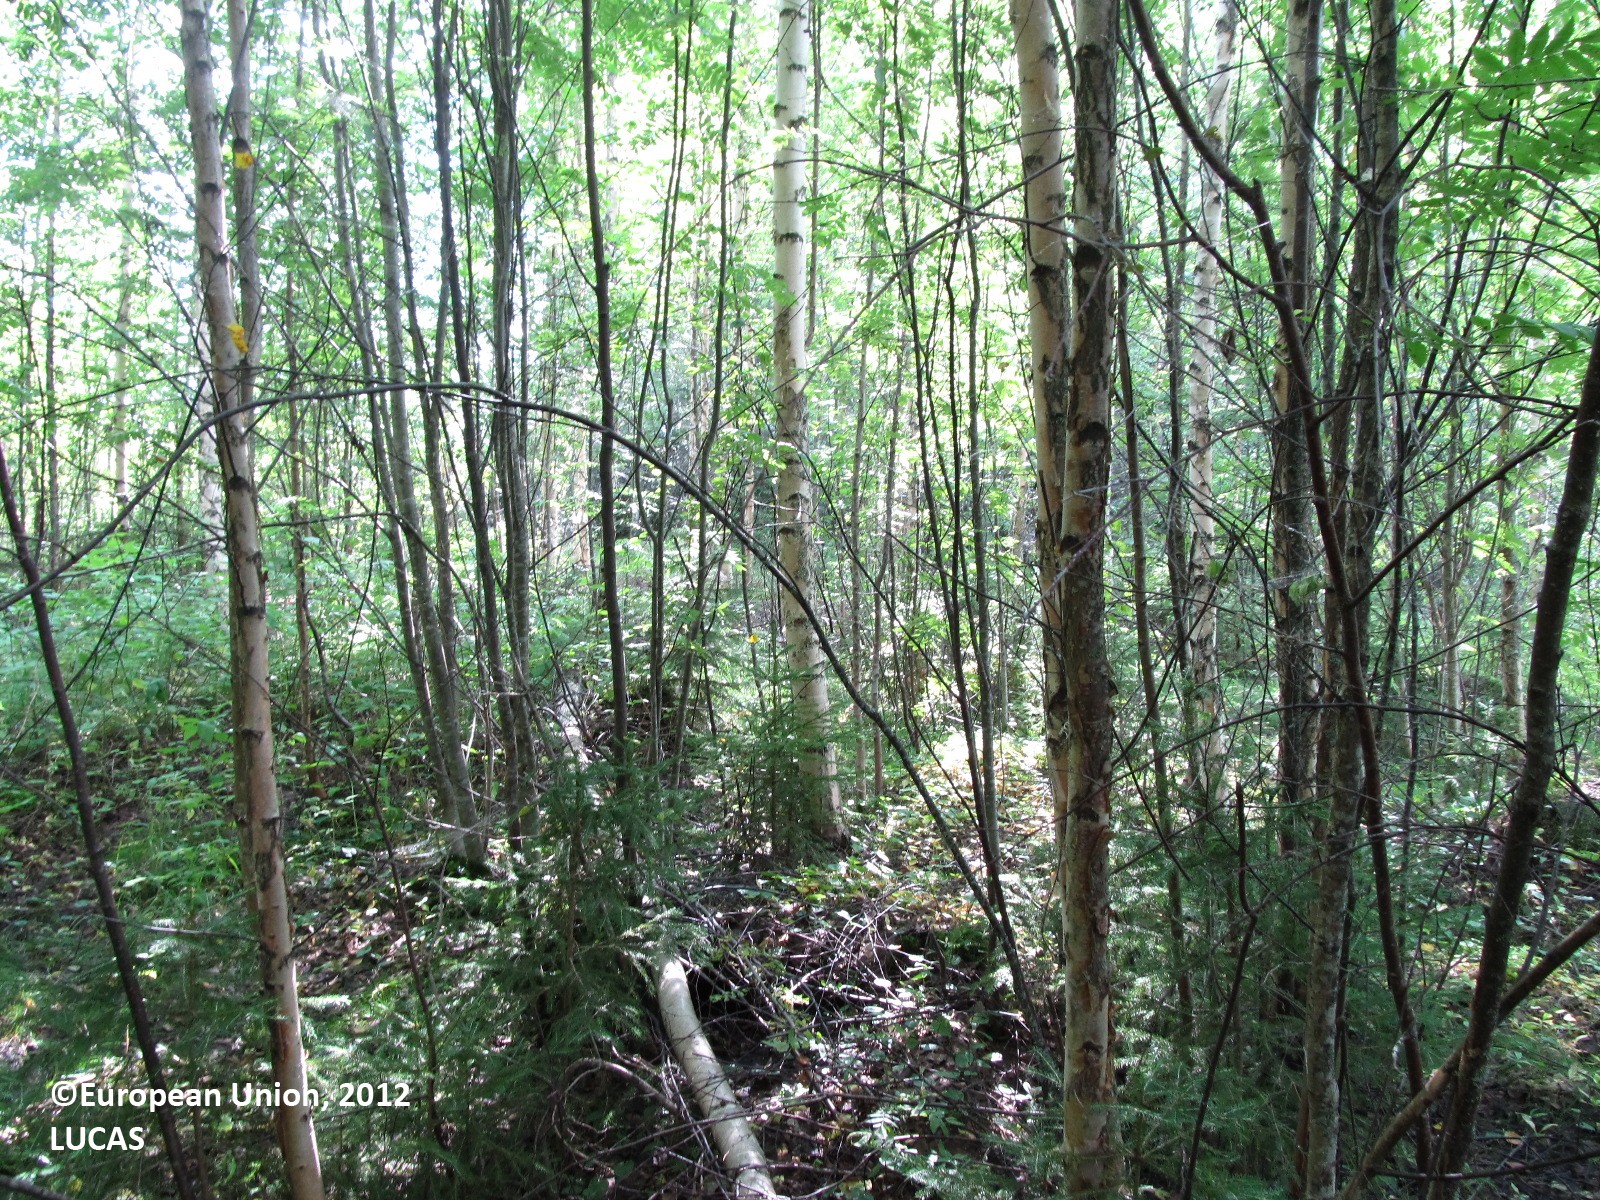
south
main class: Woodland
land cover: Broadleaved woodland
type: boreal forest
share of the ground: 25 - 50 %
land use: Forestry
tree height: > 5 m
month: July
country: FI
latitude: 62.0558
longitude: 28.1162
